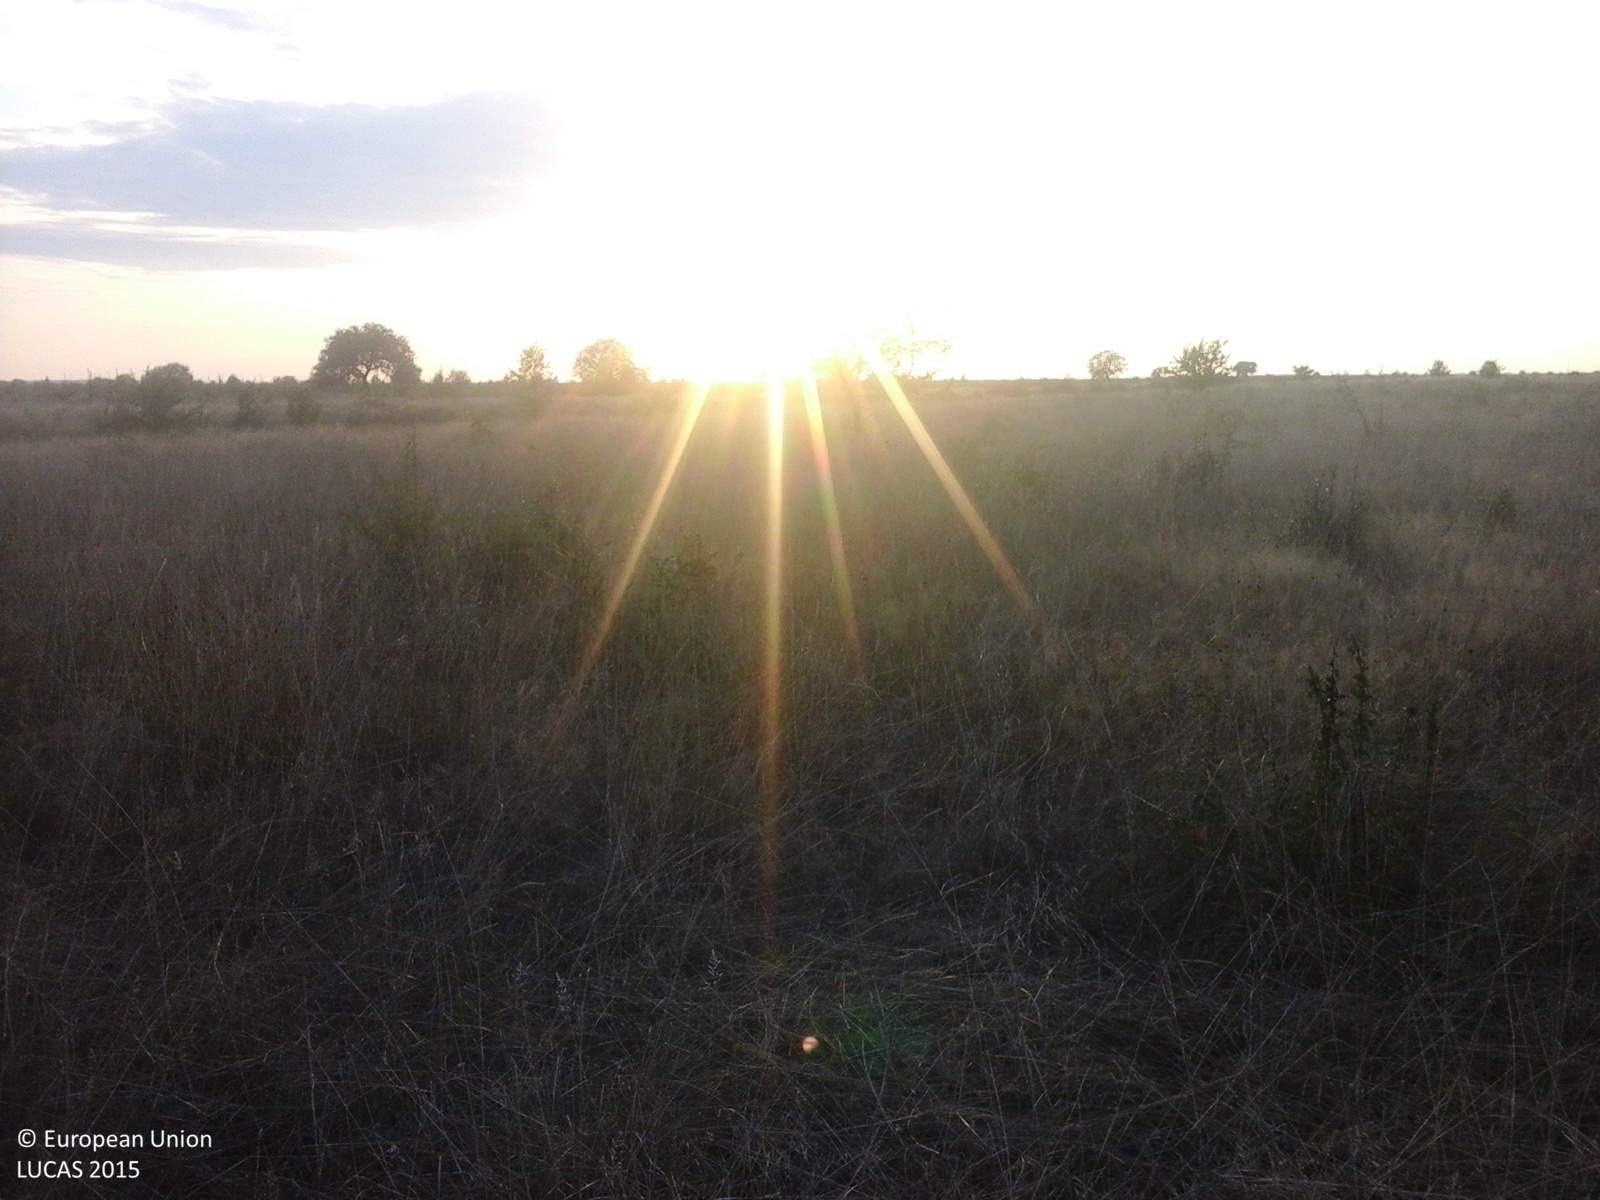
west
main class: Grassland
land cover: Grassland with sparse tree/shrub cover
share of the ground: > 75 %
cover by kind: herbaceous plants 85 %, shrubs 10 %, broadleaved forest trees 5 %
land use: Agriculture (excluding fallow land and kitchen gardens)
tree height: < 5 m
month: August
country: RO
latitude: 46.5193
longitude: 21.9181
